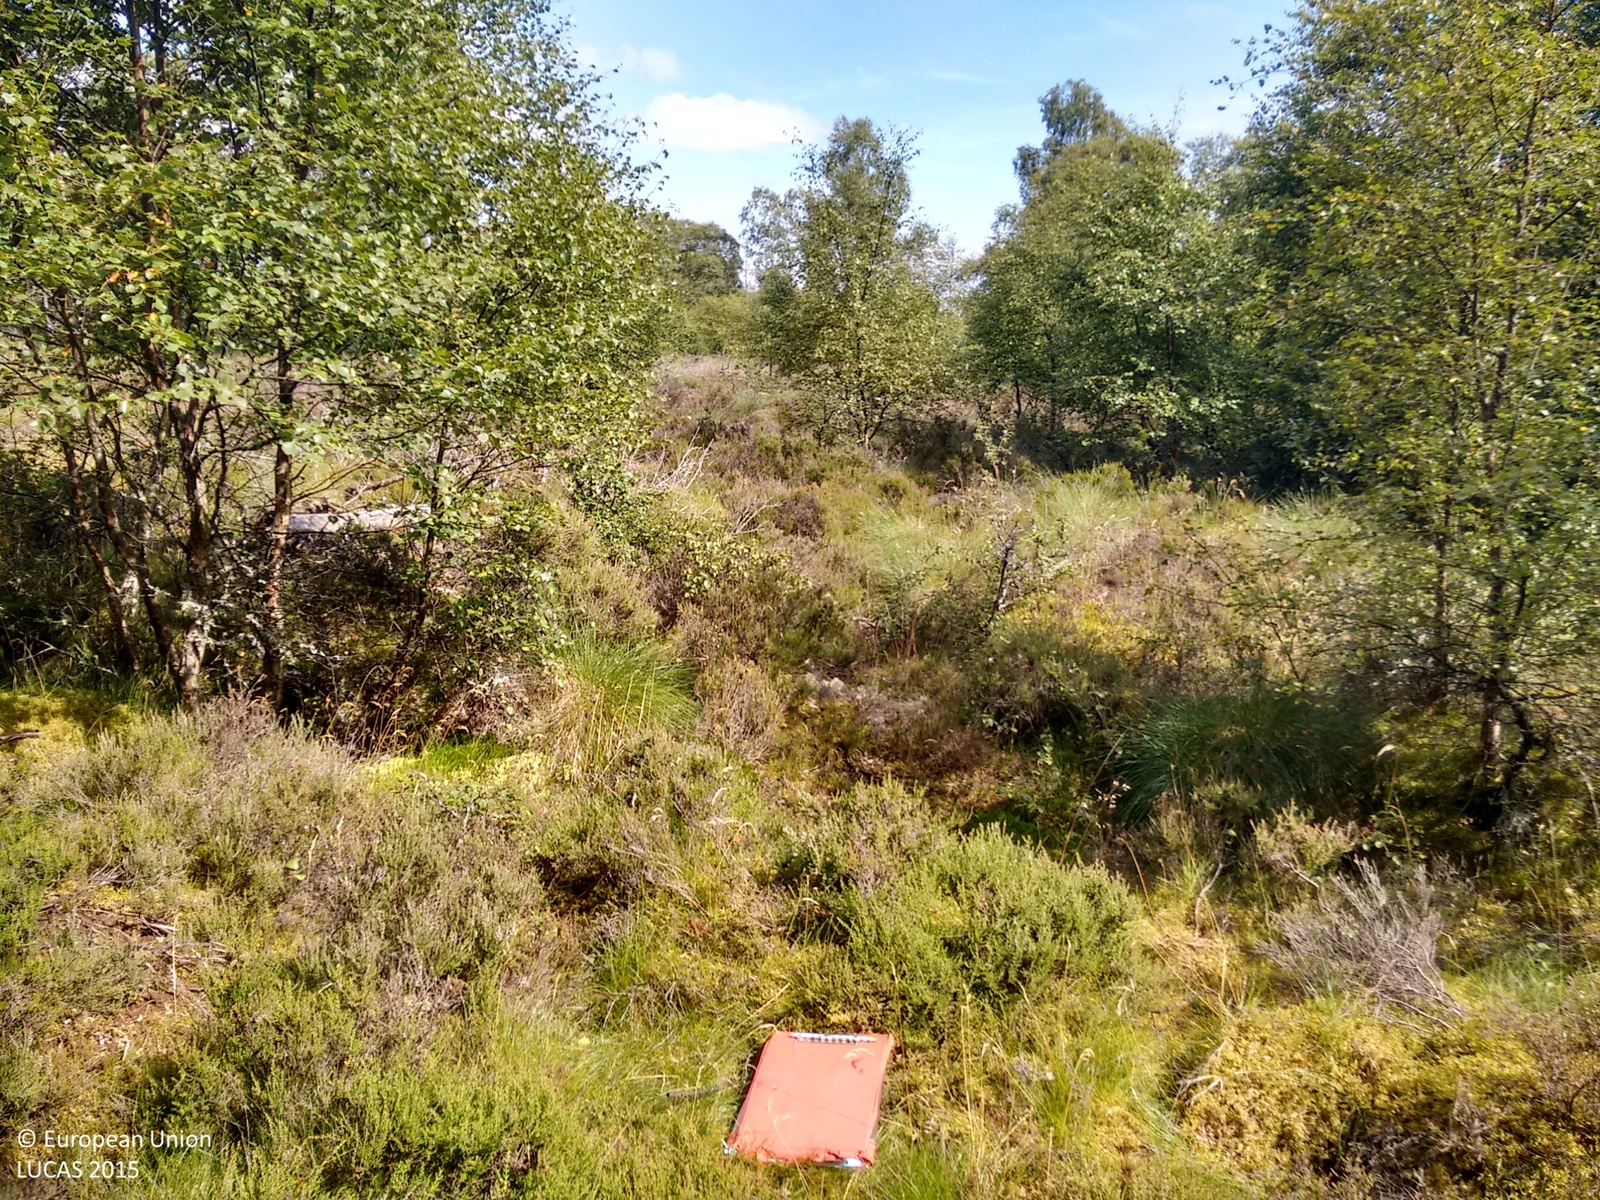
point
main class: Woodland
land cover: Other mixed woodland
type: exotic forest
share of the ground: > 75 %
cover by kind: broadleaved forest trees 55 %, coniferous forest trees 20 %, shrubs 10 %, herbaceous plants 10 %, lichens and mosses 5 %
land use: Forestry
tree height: > 5 m
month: August
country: GB
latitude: 57.5614
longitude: -3.0495
